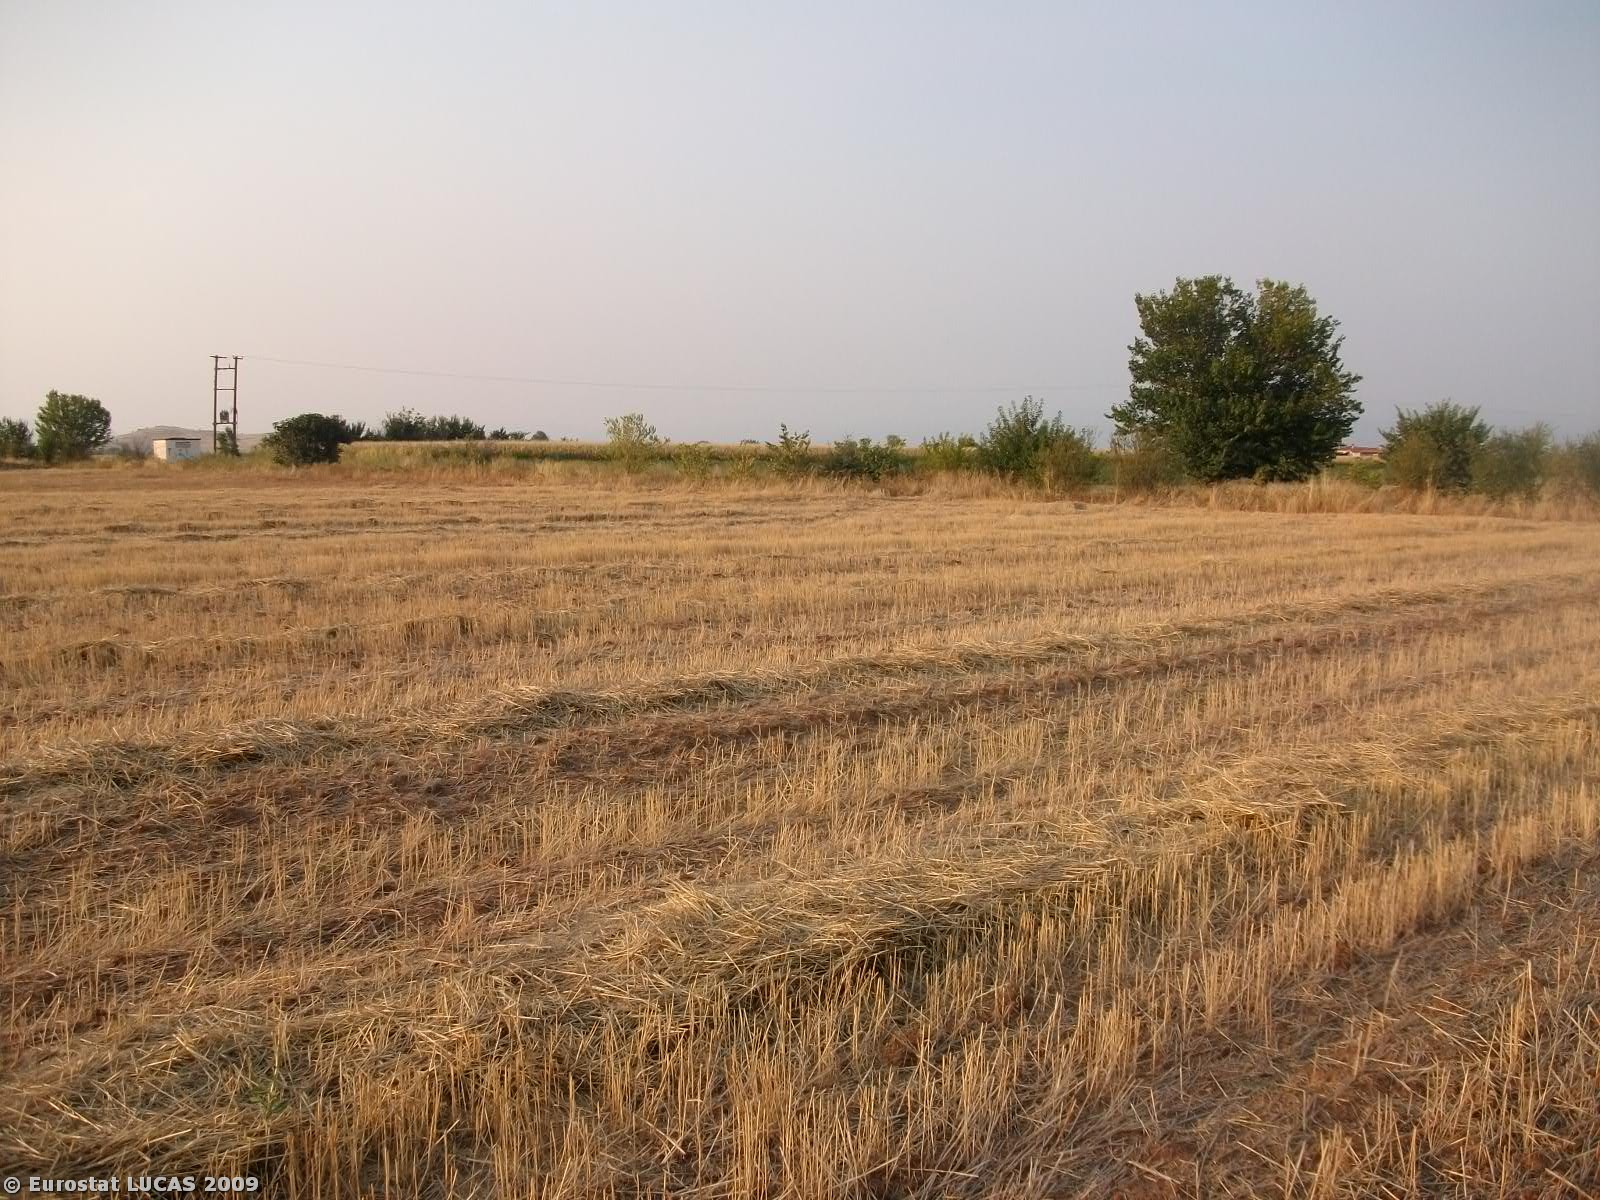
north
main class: Cropland
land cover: Durum wheat
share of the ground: < 10 %
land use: Agriculture (excluding fallow land and kitchen gardens)
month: August
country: GR
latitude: 39.4776
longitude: 21.6650
